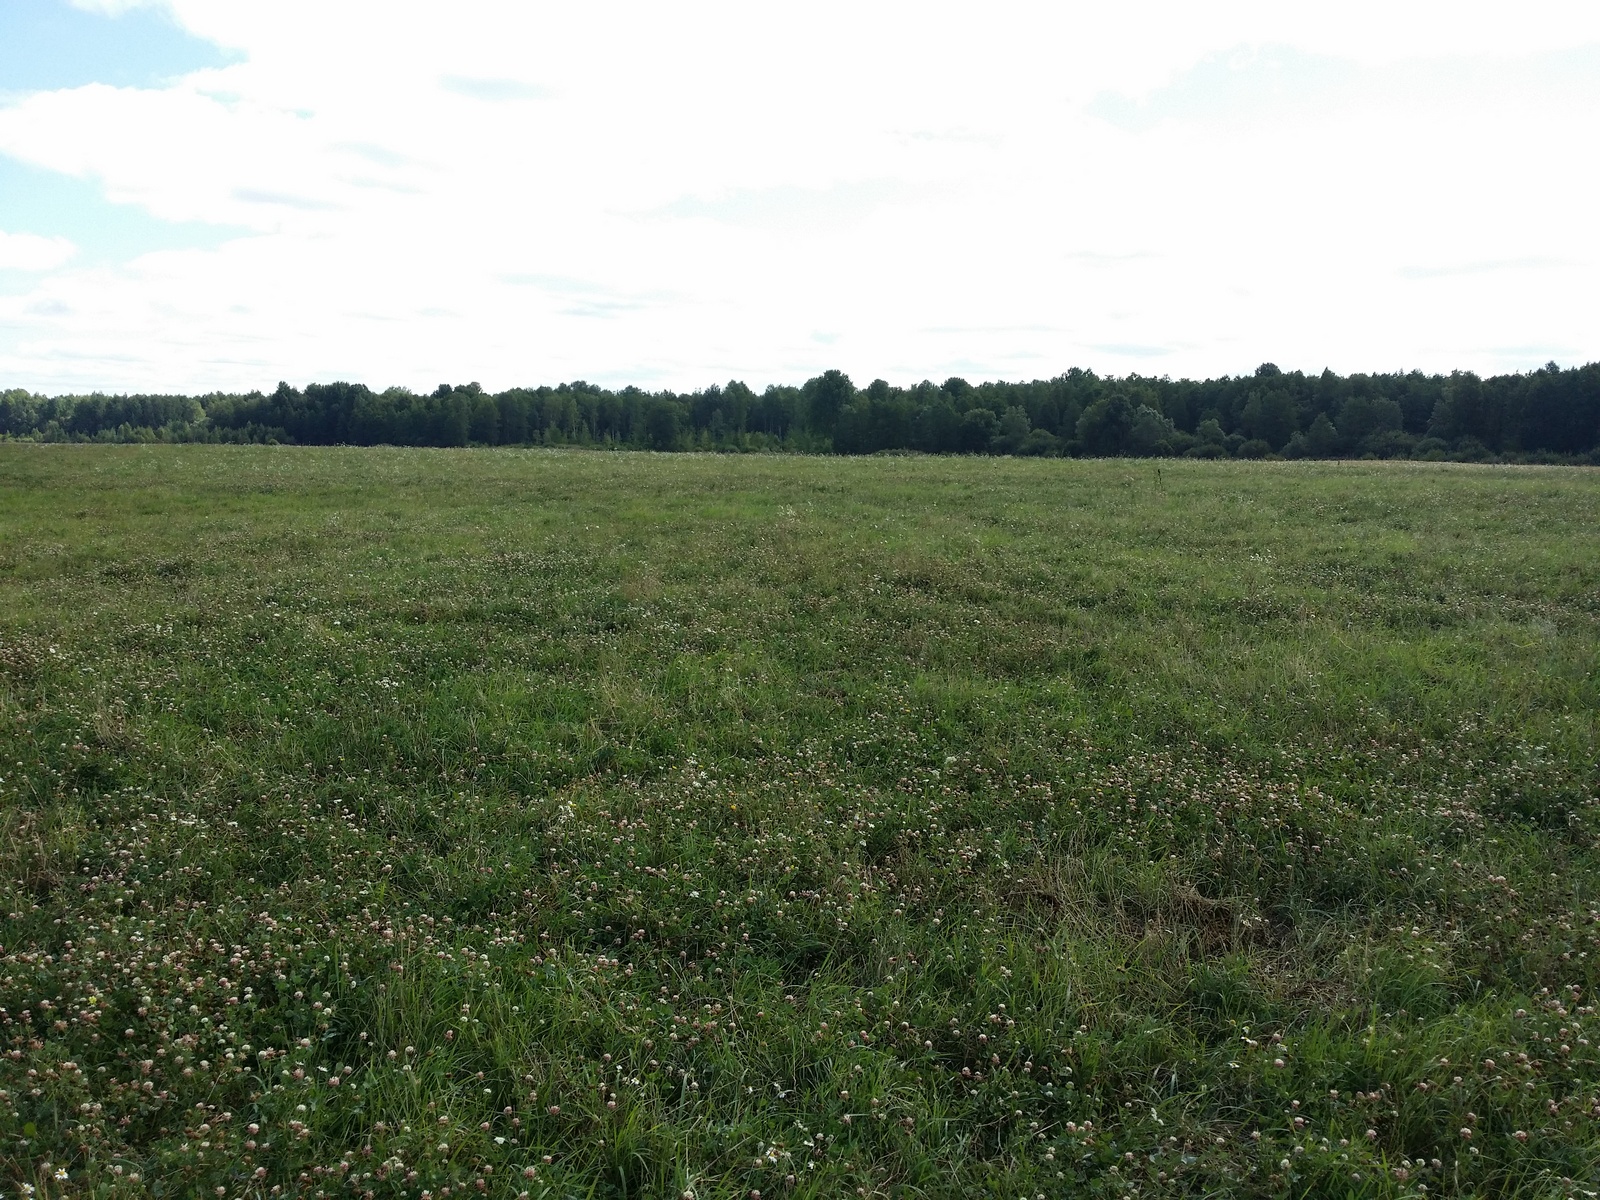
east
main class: Grassland
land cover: Grassland without tree/shrub cover
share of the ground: > 75 %
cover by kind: herbaceous plants 95 %, unconsolidated bare surface 5 %
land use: Agriculture (excluding fallow land and kitchen gardens)
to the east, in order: Grassland without tree/shrub cover; Spontaneously vegetated surfaces; Fences; Other cereals
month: August
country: LV
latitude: 57.2076
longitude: 27.7489
